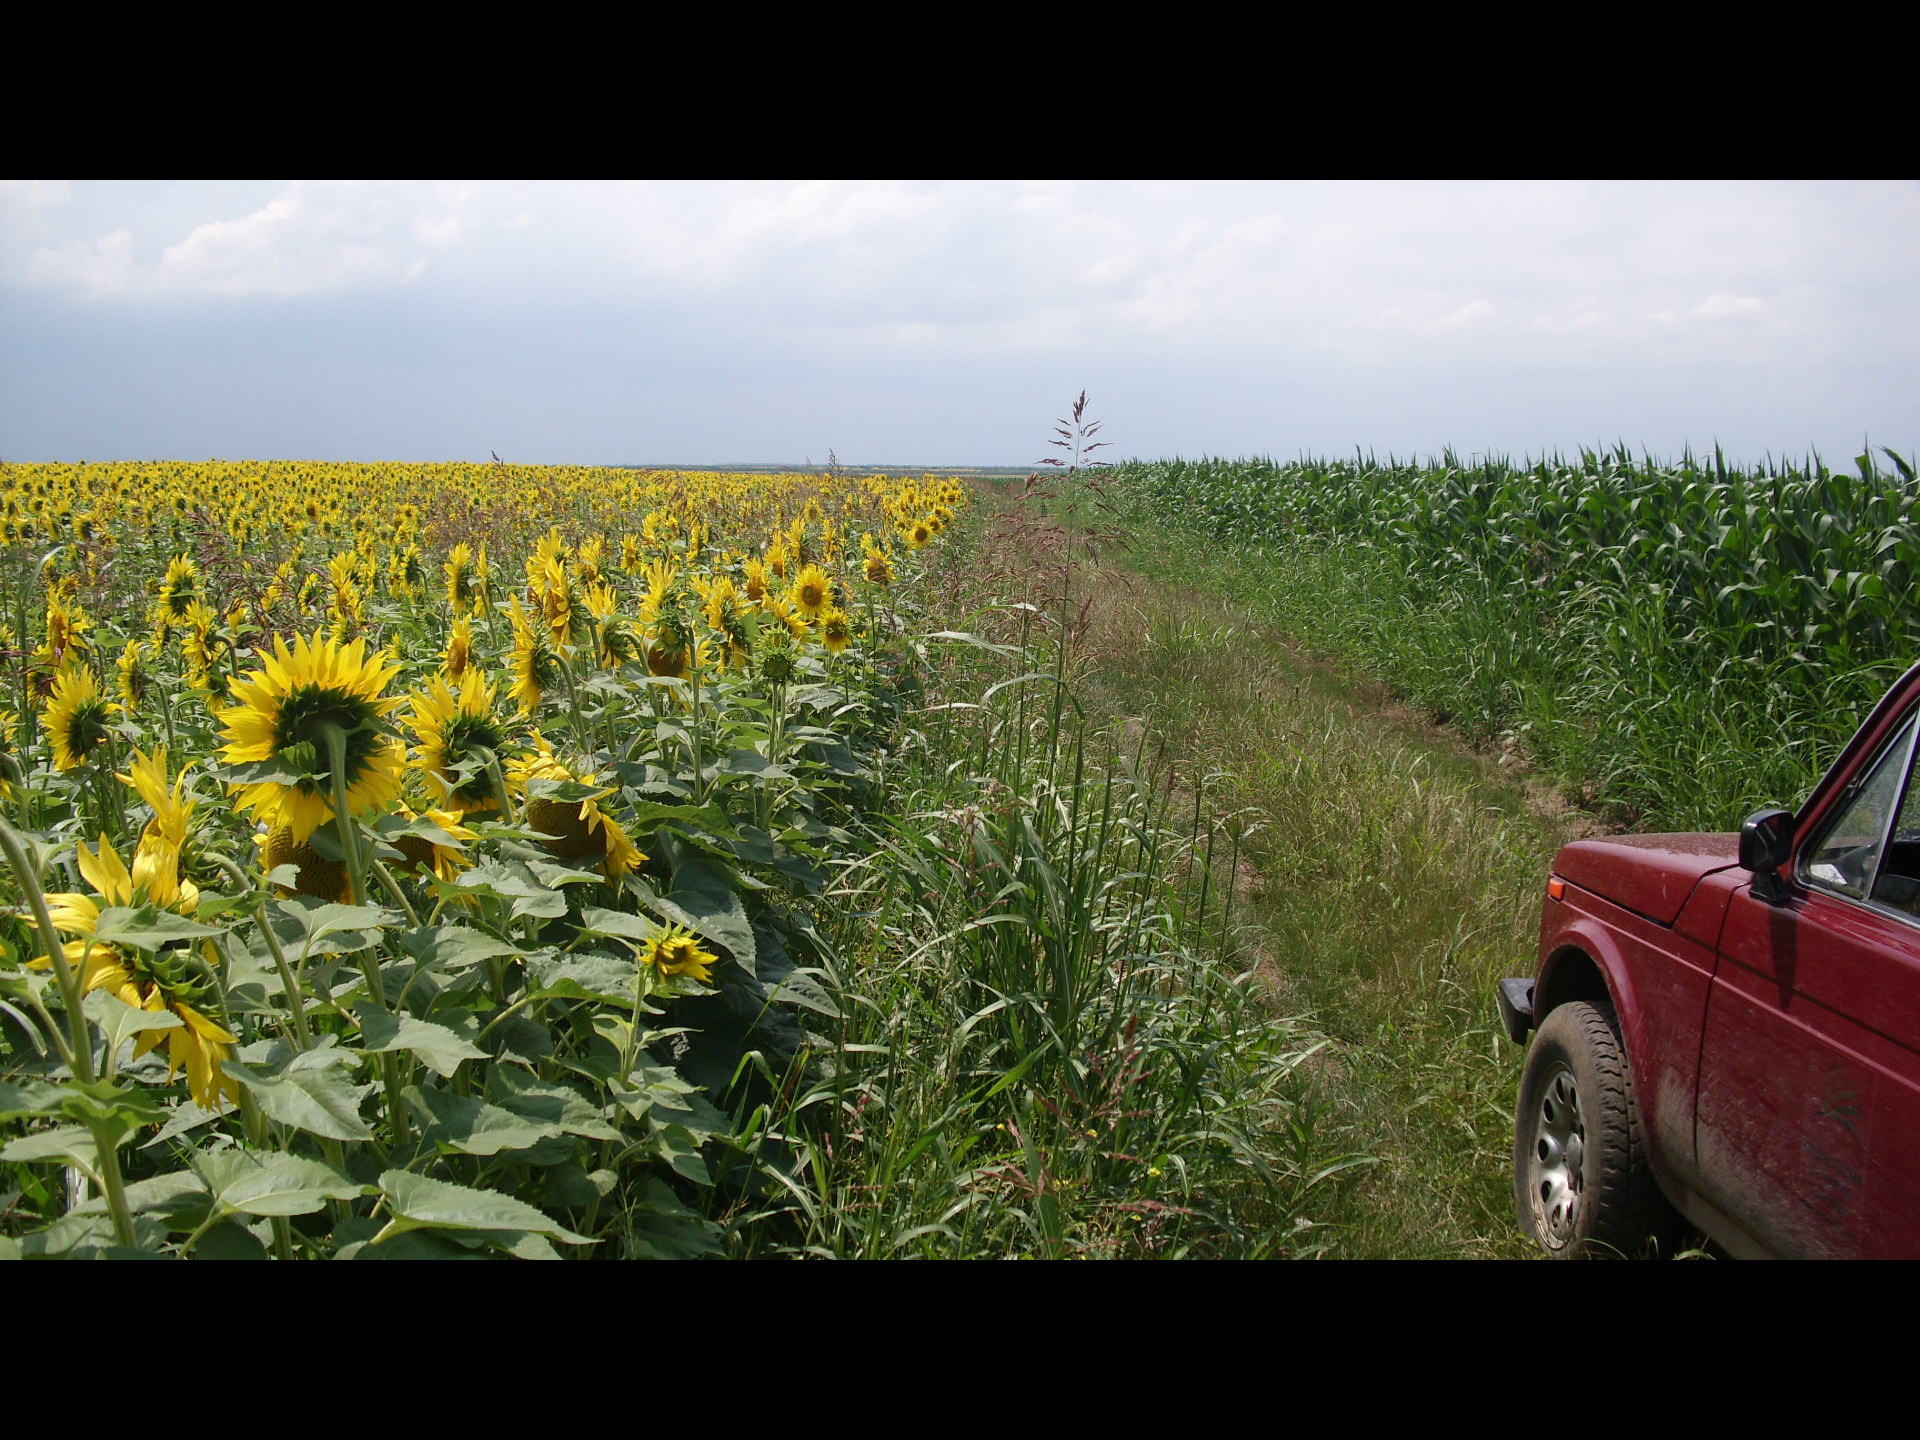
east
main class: Cropland
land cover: Sunflower
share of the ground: > 75 %
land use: Agriculture (excluding fallow land and kitchen gardens)
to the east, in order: Sunflower
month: June
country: BG
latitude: 43.7175
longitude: 23.2366
